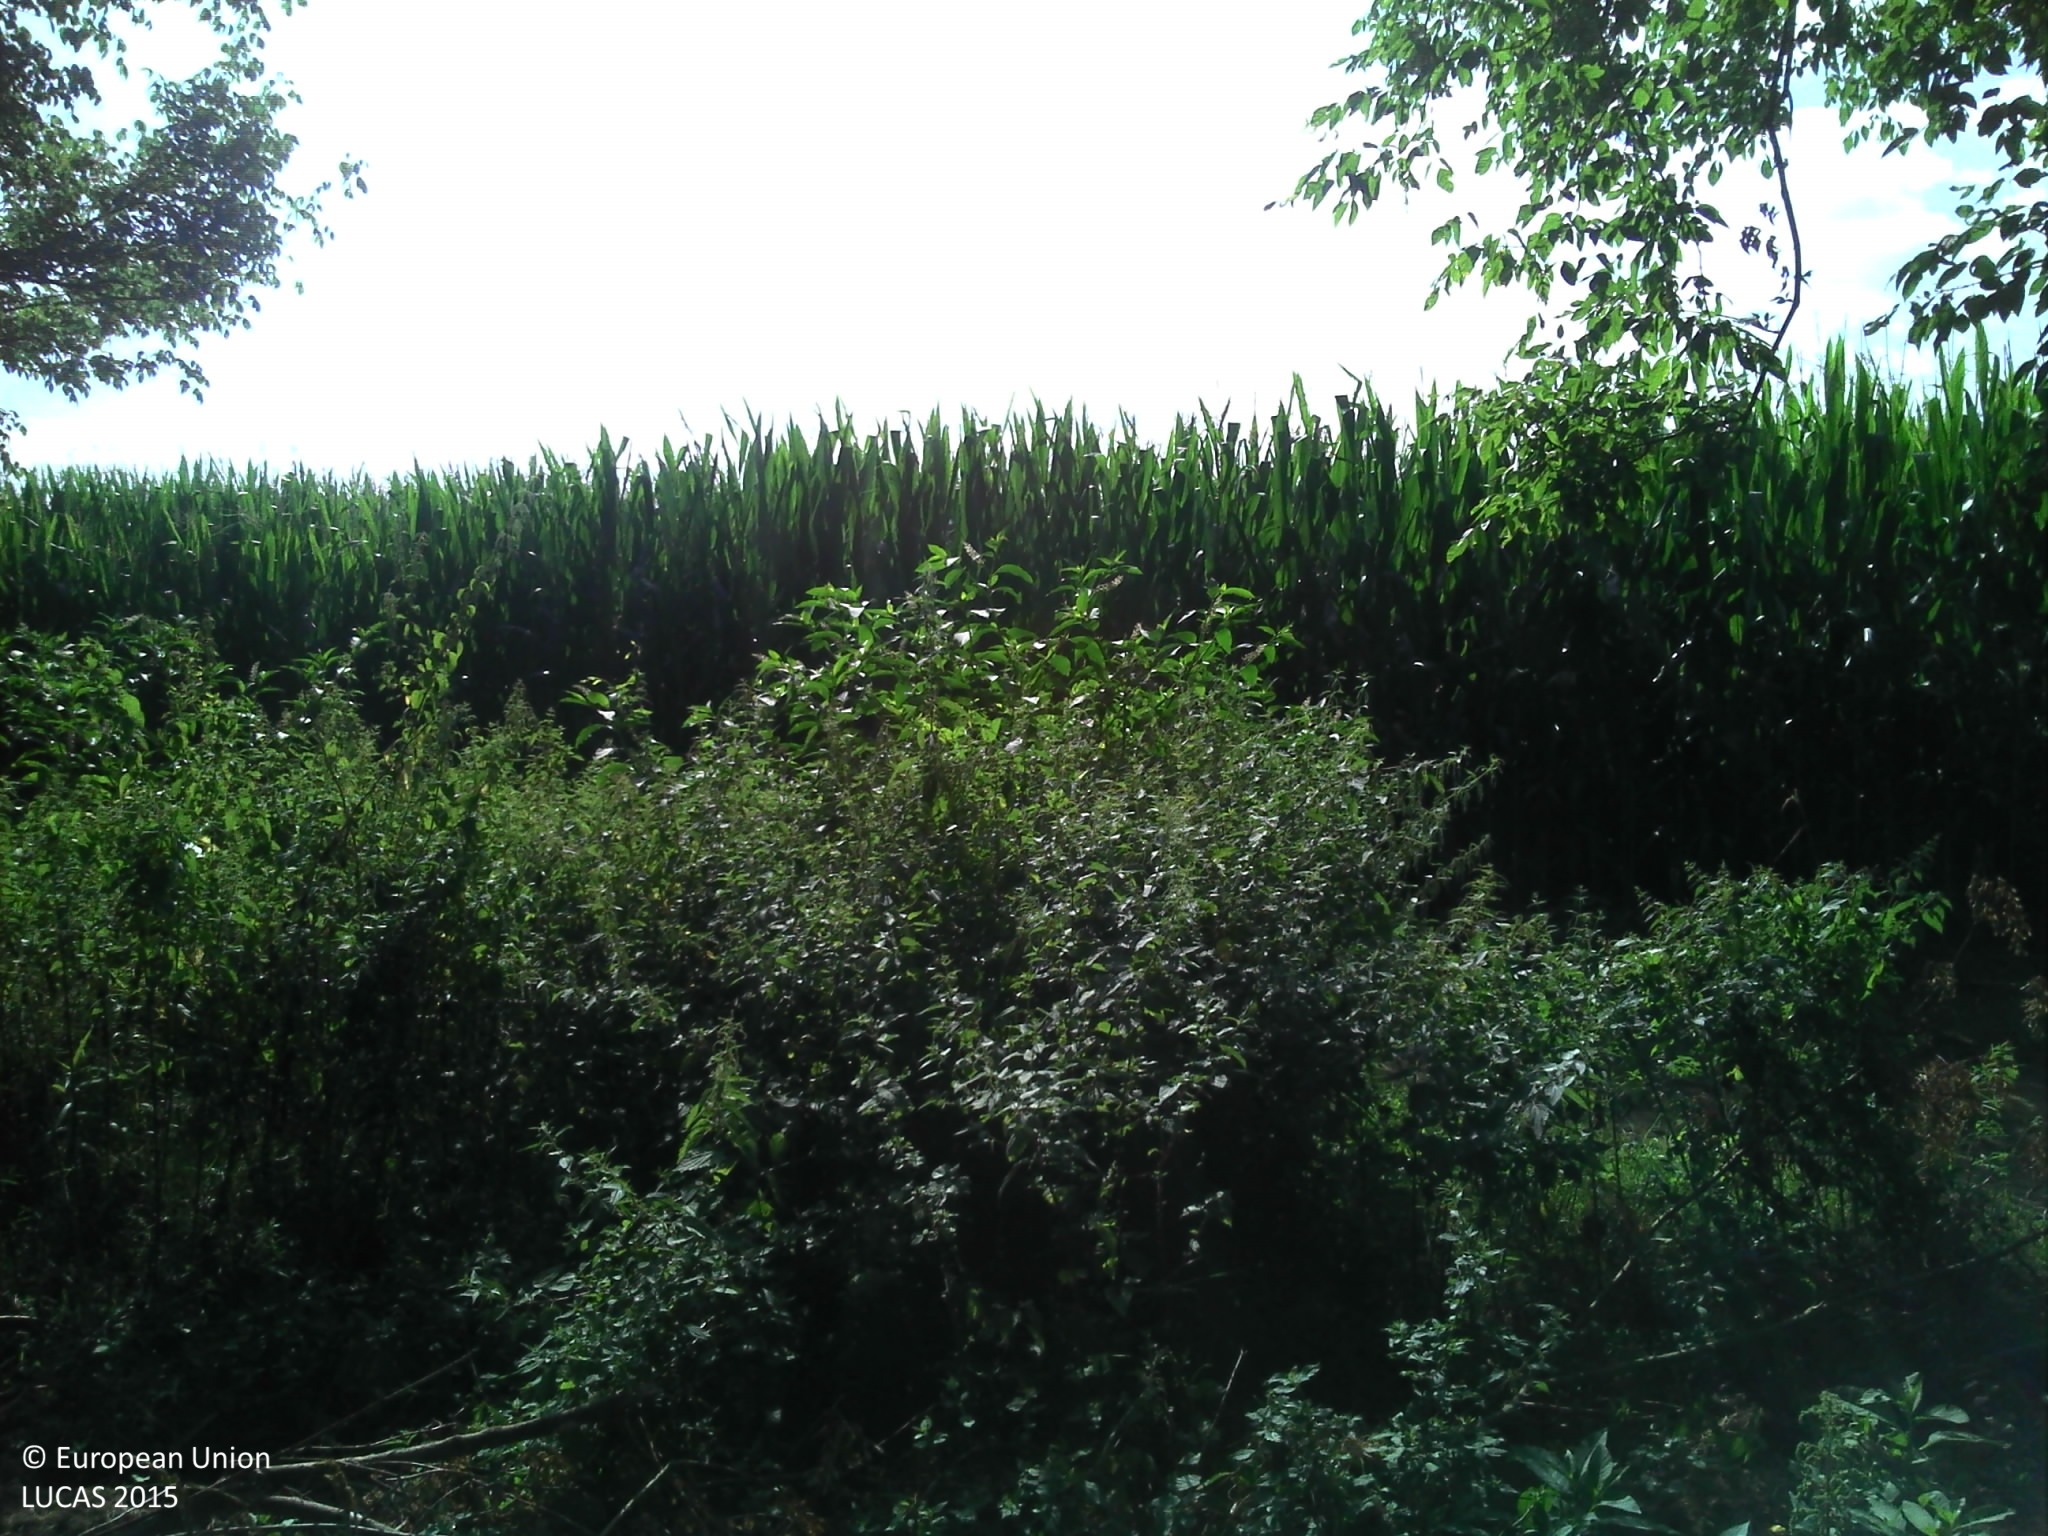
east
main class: Woodland
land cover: Broadleaved woodland
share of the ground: > 75 %
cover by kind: broadleaved forest trees 75 %, herbaceous plants 20 %, lichens and mosses 5 %
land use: Forestry
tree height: > 5 m
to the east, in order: Broadleaved woodland; Inland fresh running water; Broadleaved woodland; Grass margins; Tracks; Maize; Ditches and canals; Maize; Electric lines; Maize
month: July
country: FR
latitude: 43.8605
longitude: -0.7762
